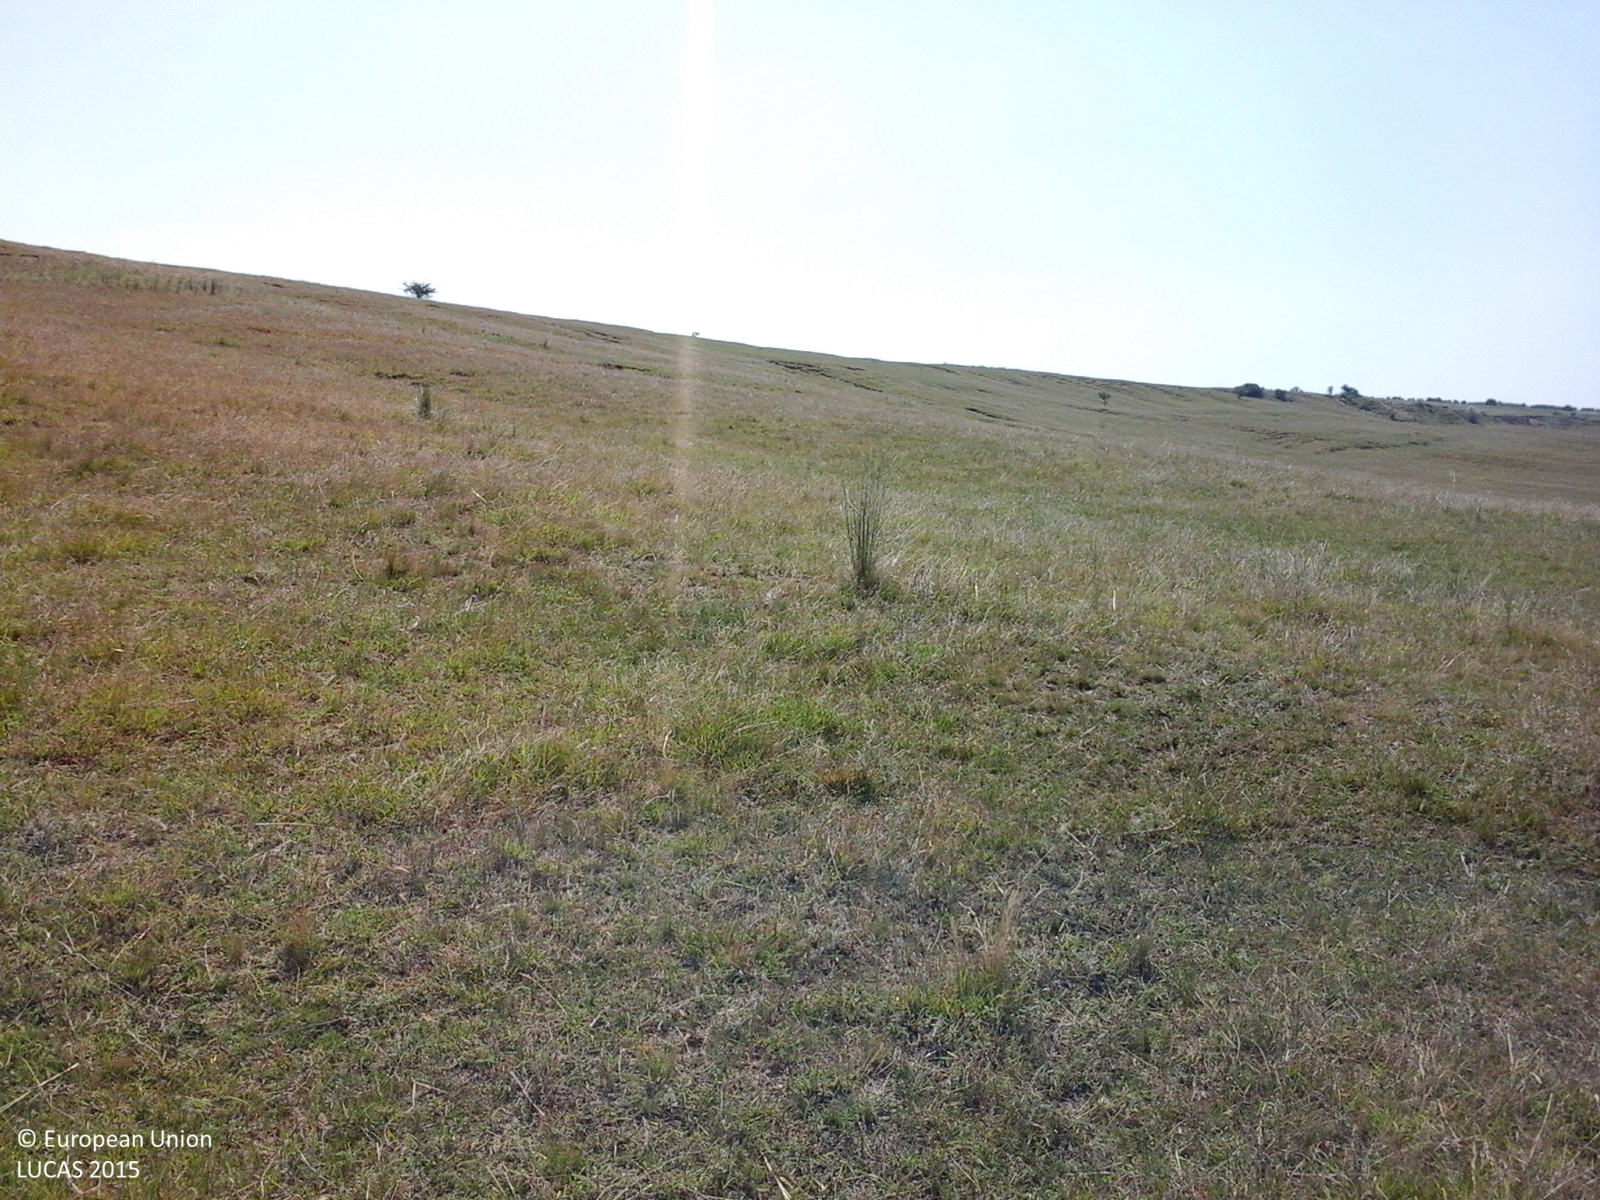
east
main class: Grassland
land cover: Grassland without tree/shrub cover
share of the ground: > 75 %
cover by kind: herbaceous plants 100 %
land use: Agriculture (excluding fallow land and kitchen gardens)
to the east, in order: Grassland without tree/shrub cover
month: June
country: RO
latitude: 46.8445
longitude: 27.9484
